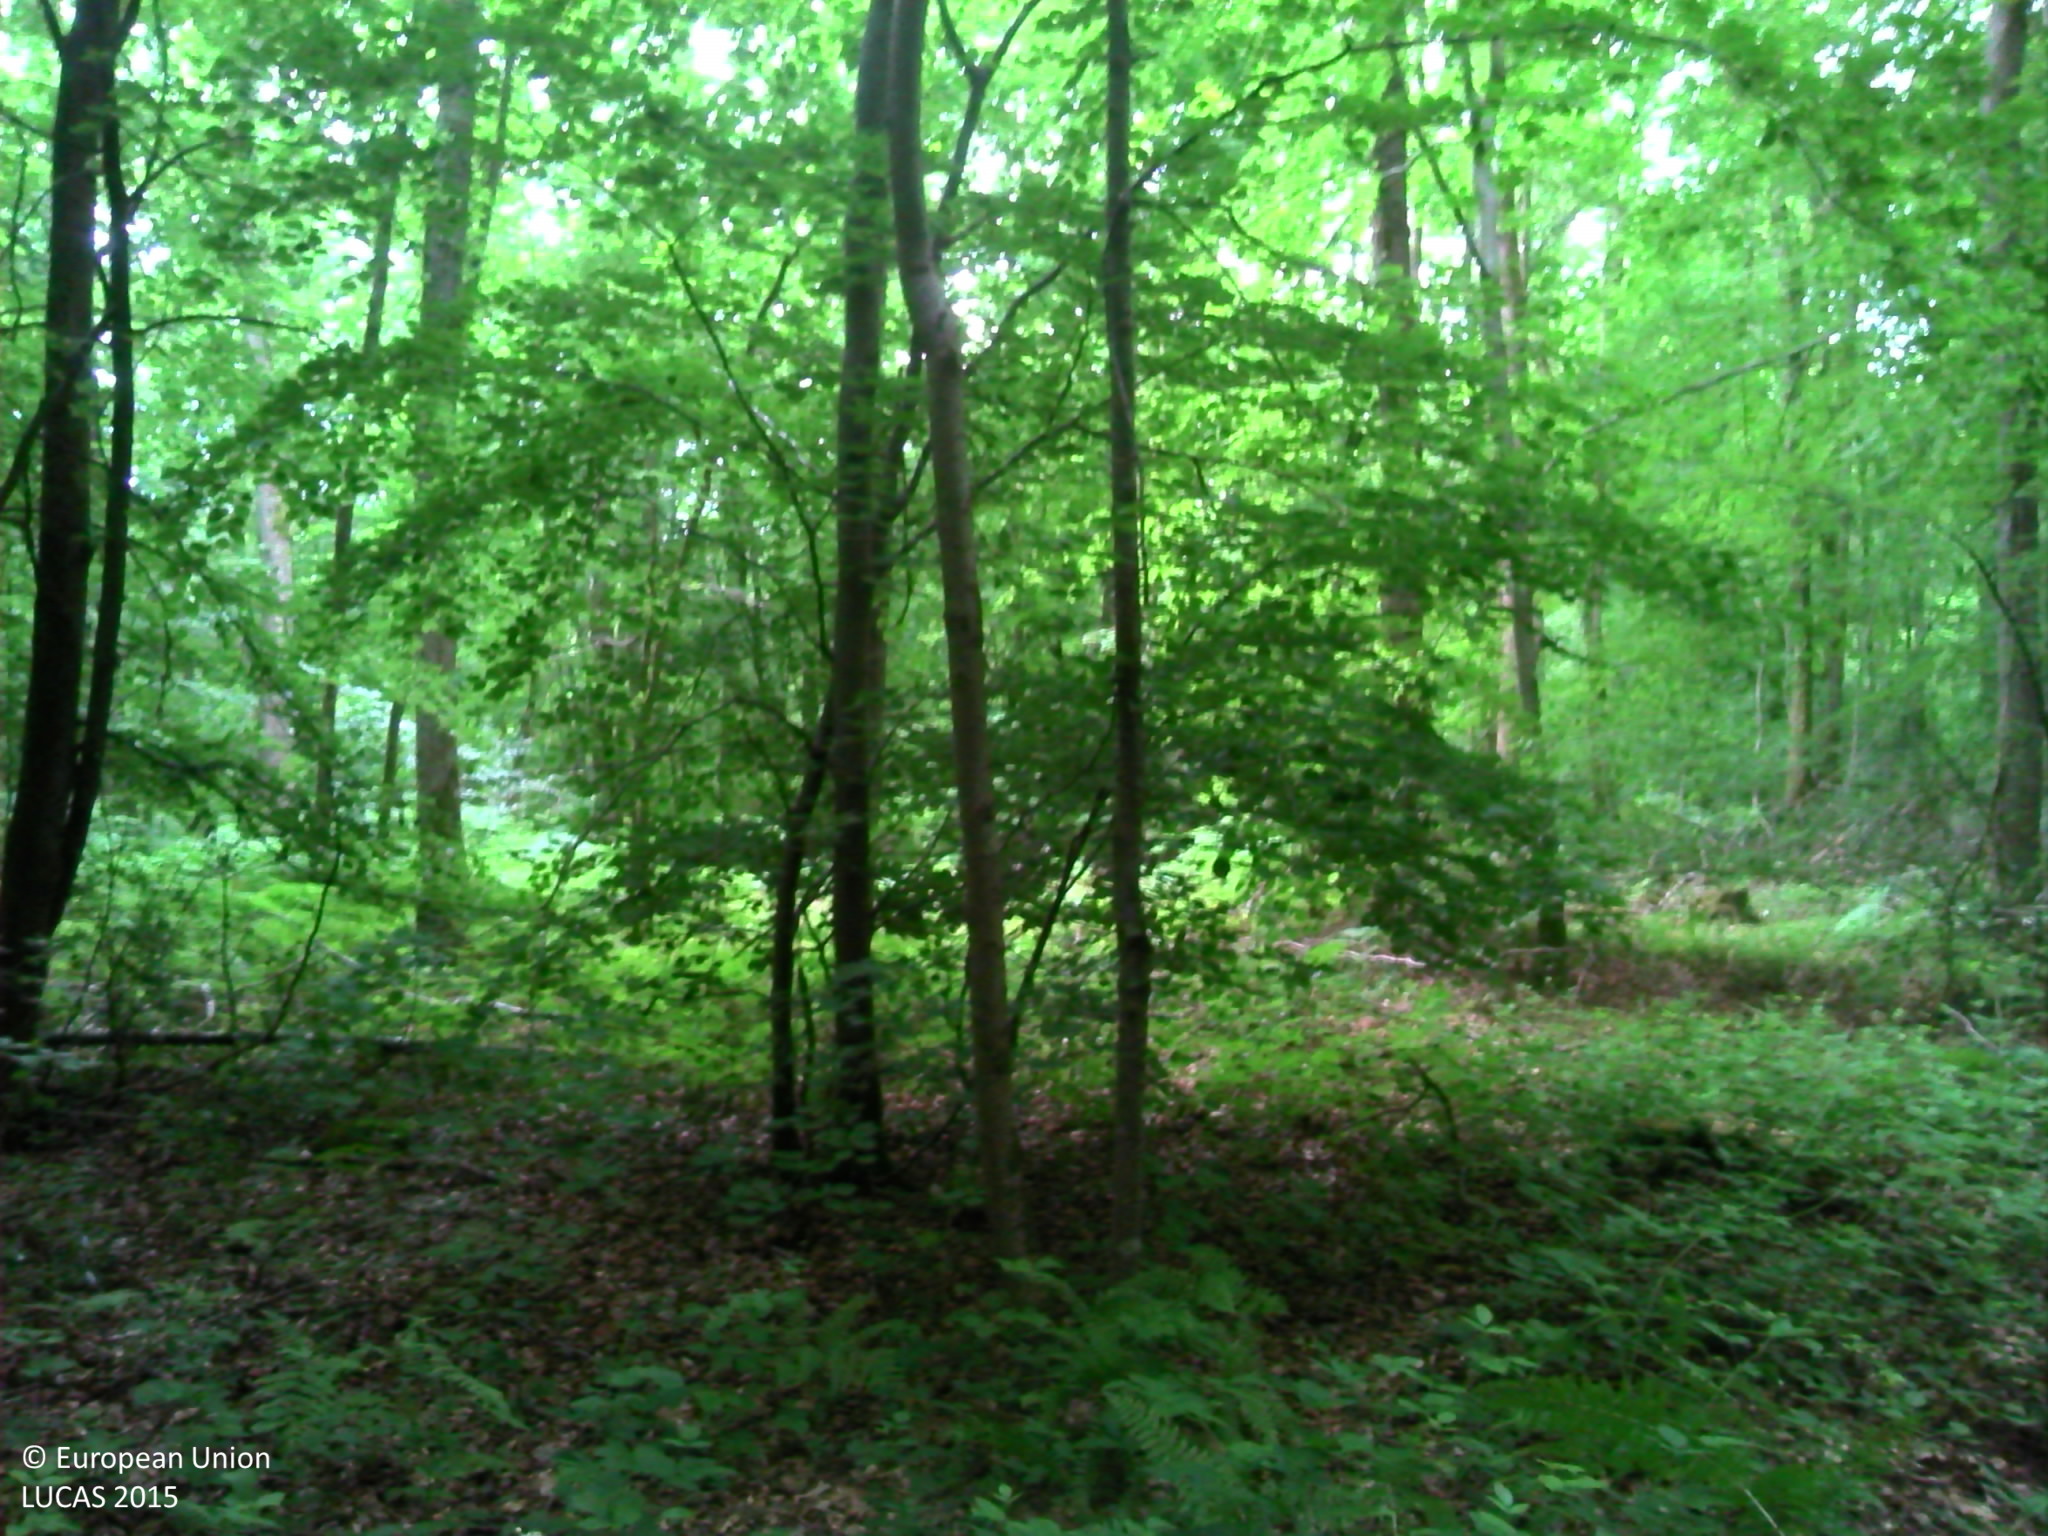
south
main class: Woodland
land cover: Broadleaved woodland
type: acidophilous oak and oak-birch forest
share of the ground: > 75 %
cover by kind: broadleaved forest trees 75 %, coniferous forest trees 10 %, herbaceous plants 10 %, shrubs 5 %
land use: Forestry
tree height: > 5 m
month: July
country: FR
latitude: 48.9345
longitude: 0.0732
